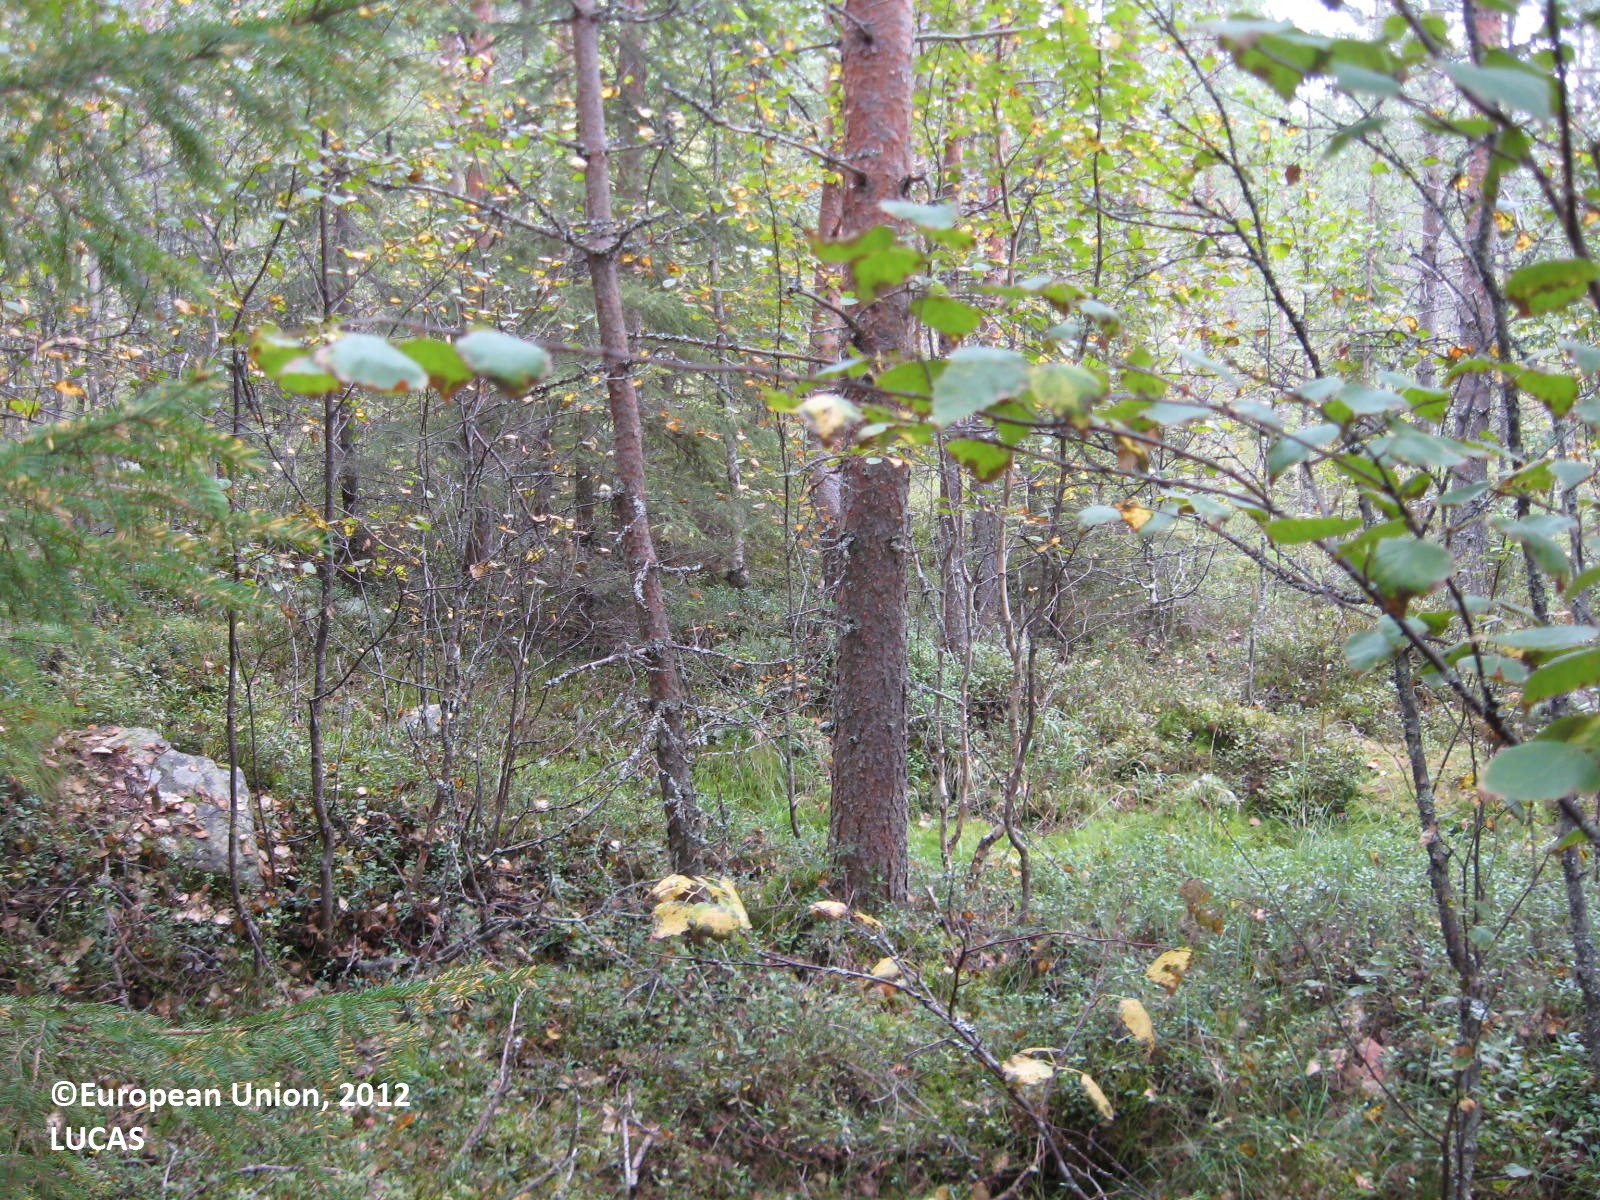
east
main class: Woodland
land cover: Pine dominated mixed woodland
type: boreal forest
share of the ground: > 75 %
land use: Forestry
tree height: > 5 m
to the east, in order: Pine dominated mixed woodland; Ditches and canals; Pine dominated mixed woodland
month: August
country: FI
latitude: 63.5467
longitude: 30.3215
